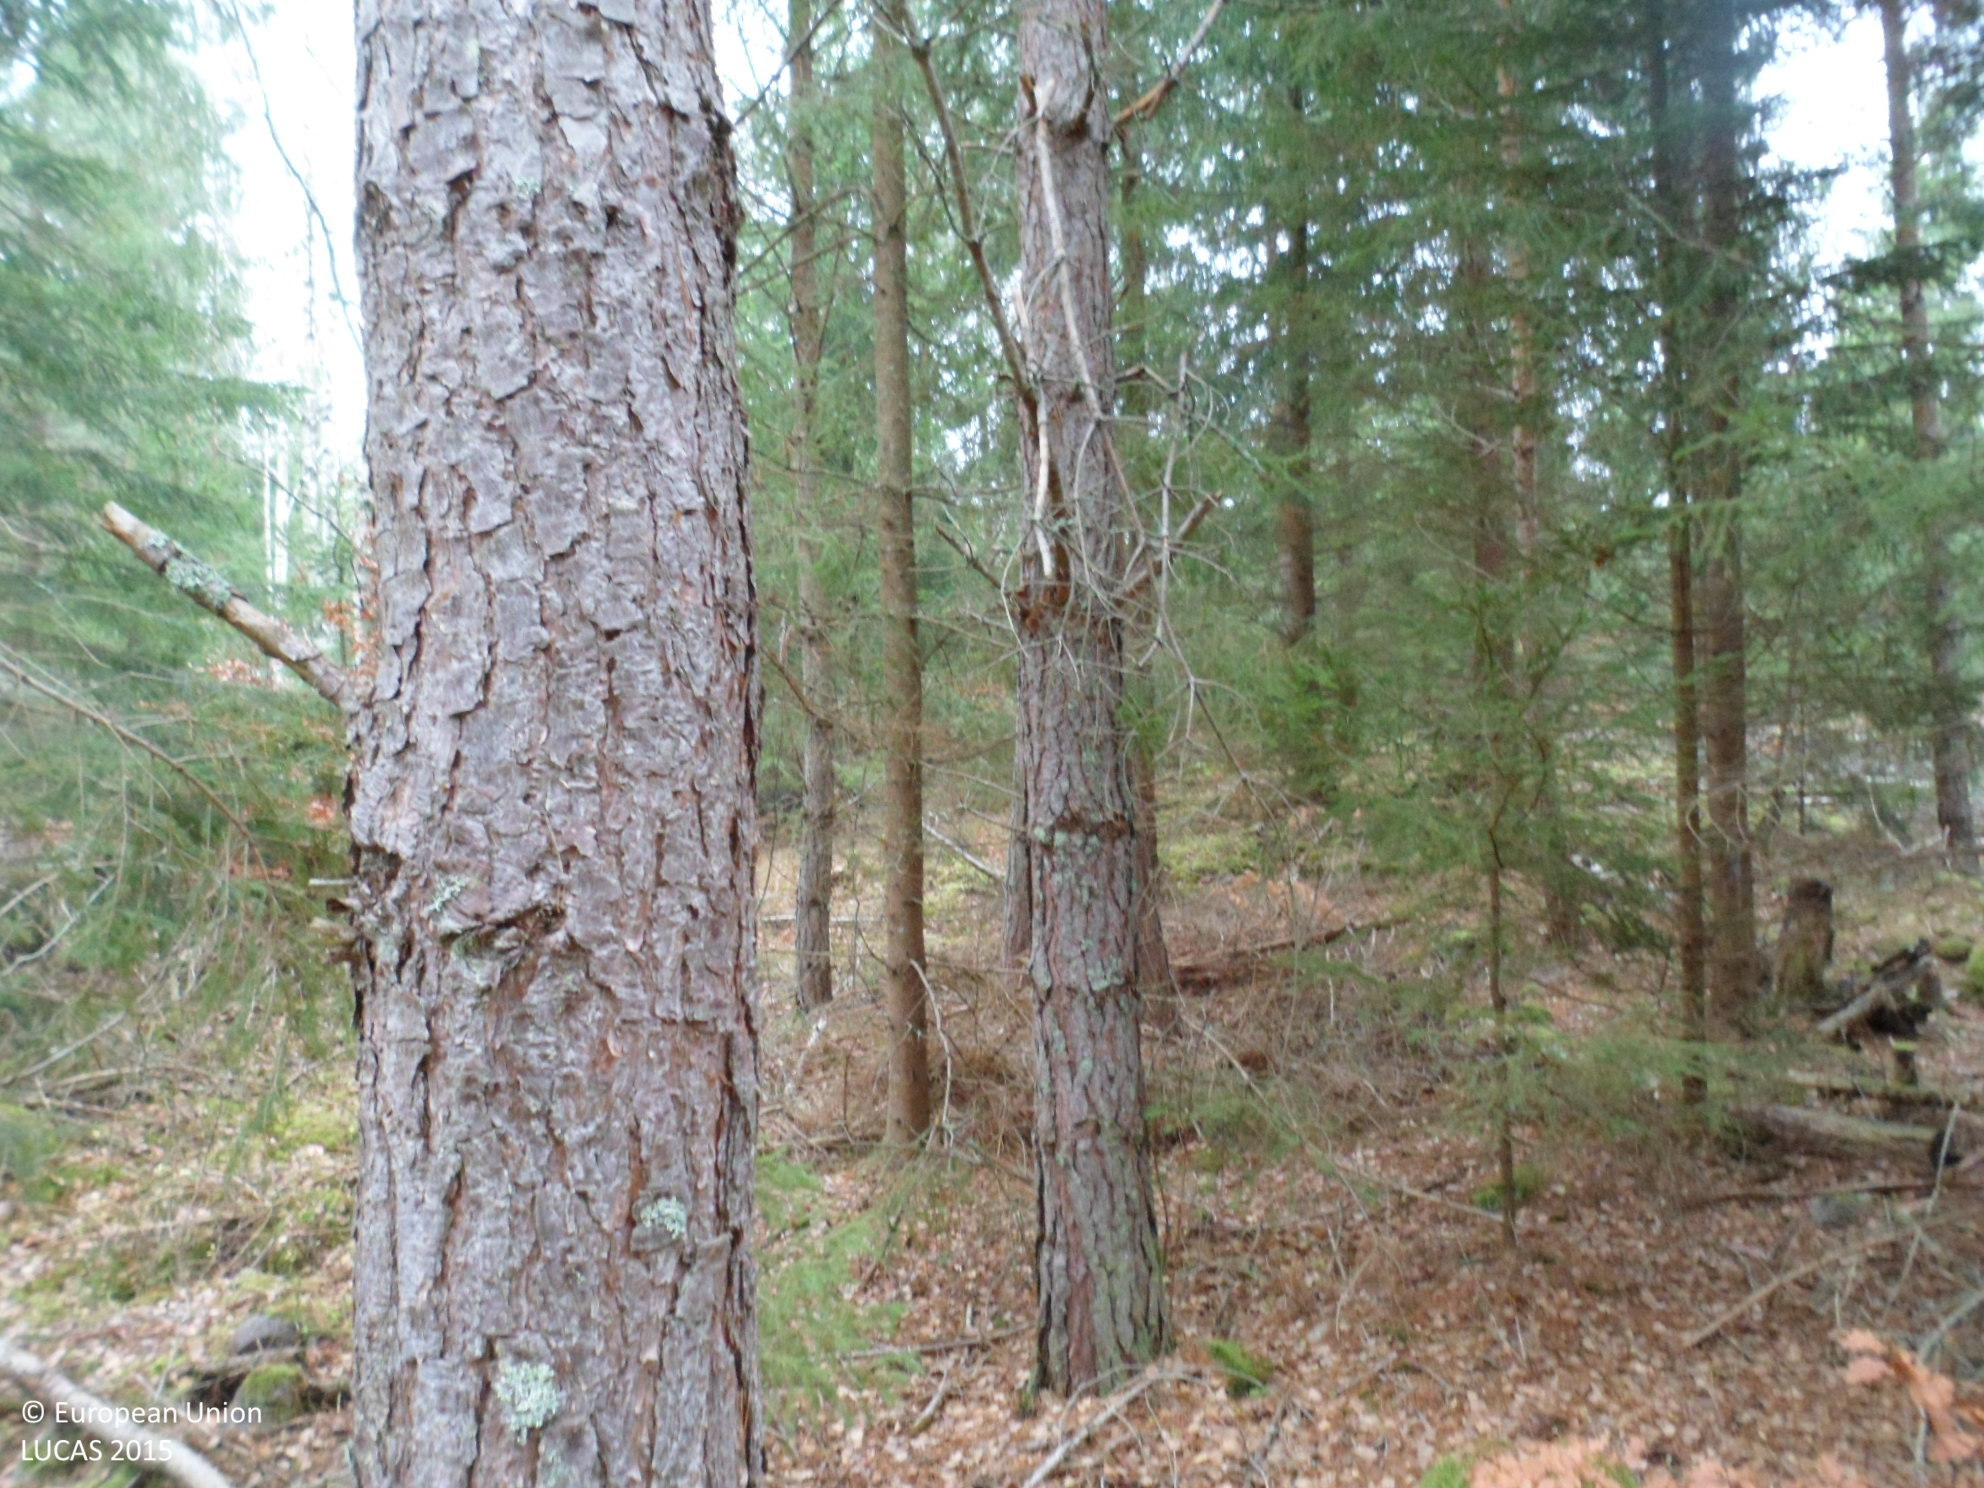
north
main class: Woodland
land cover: Pine dominated coniferous woodland
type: boreal forest
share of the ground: 50 - 75 %
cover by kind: coniferous forest trees 50 %, lichens and mosses 15 %, unconsolidated bare surface 15 %, broadleaved forest trees 10 %, shrubs 10 %
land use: Forestry
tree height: > 5 m
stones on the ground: > 50 %
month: November
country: SE
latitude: 57.0489
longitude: 16.1811
